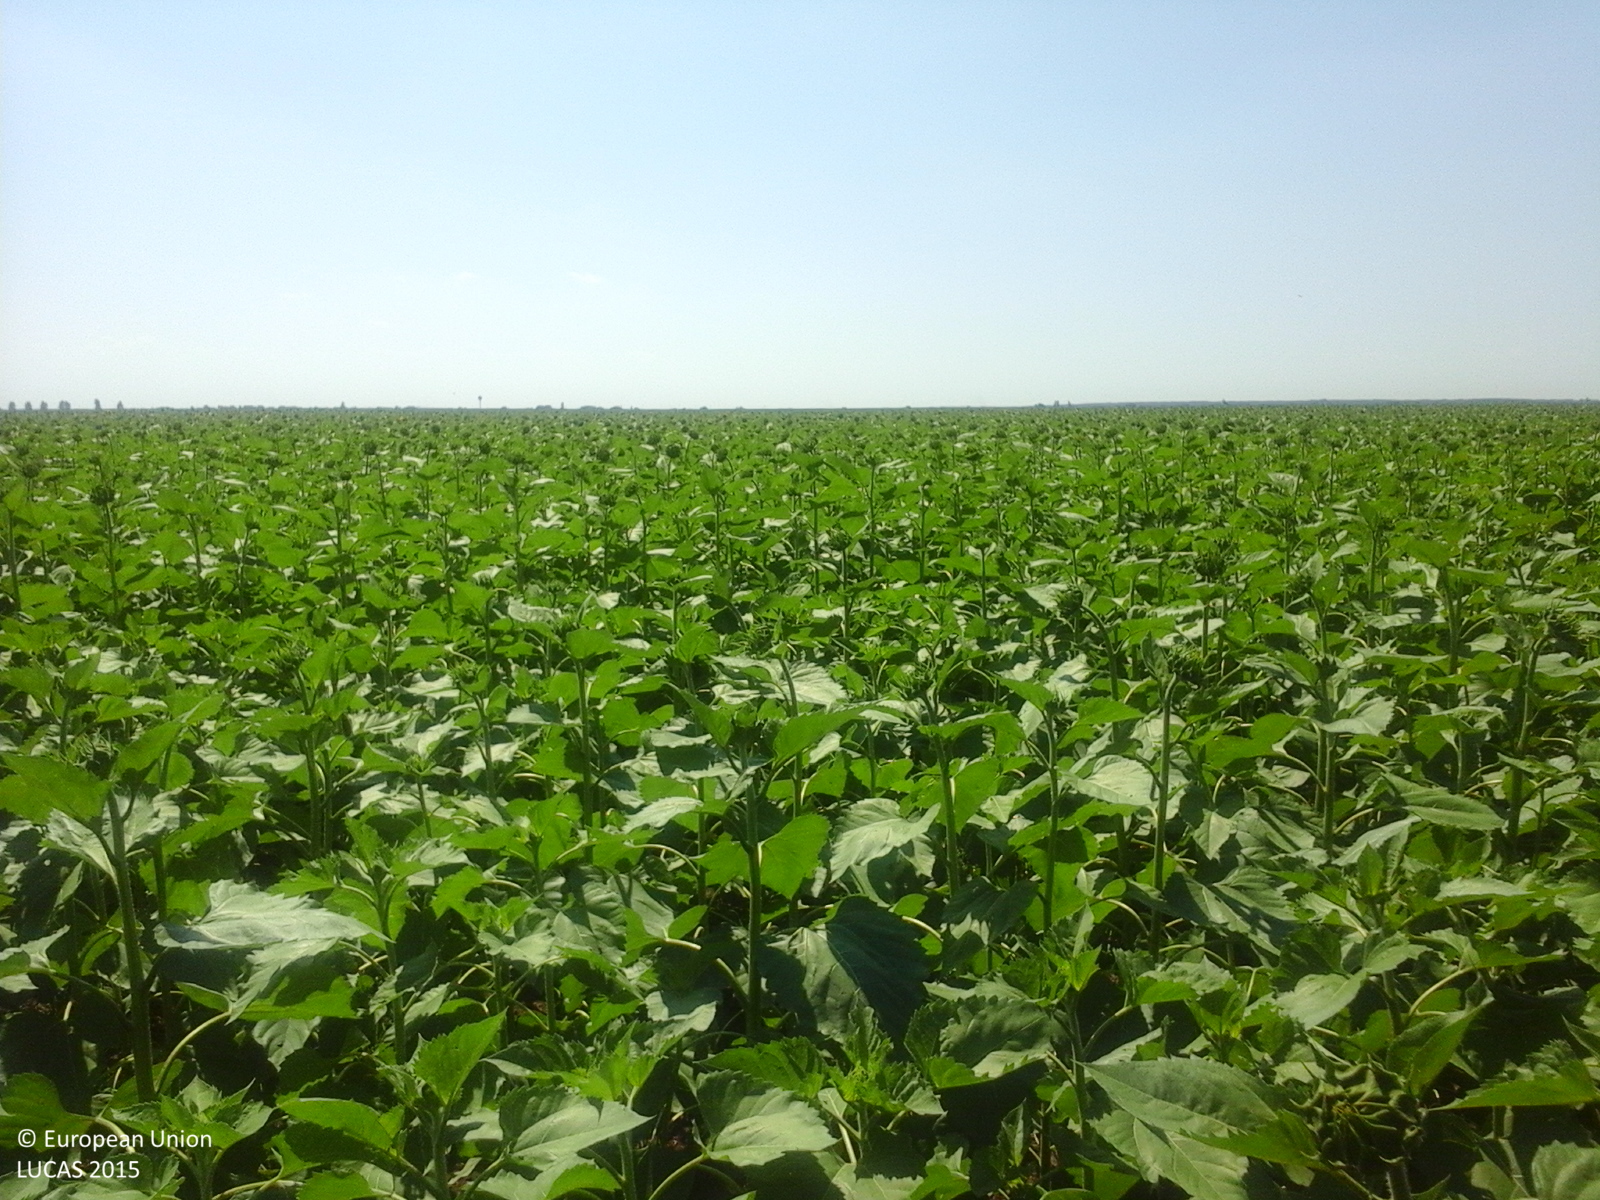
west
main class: Cropland
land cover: Sunflower
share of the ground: > 75 %
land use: Agriculture (excluding fallow land and kitchen gardens)
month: July
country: RO
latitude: 44.1414
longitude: 24.6845
